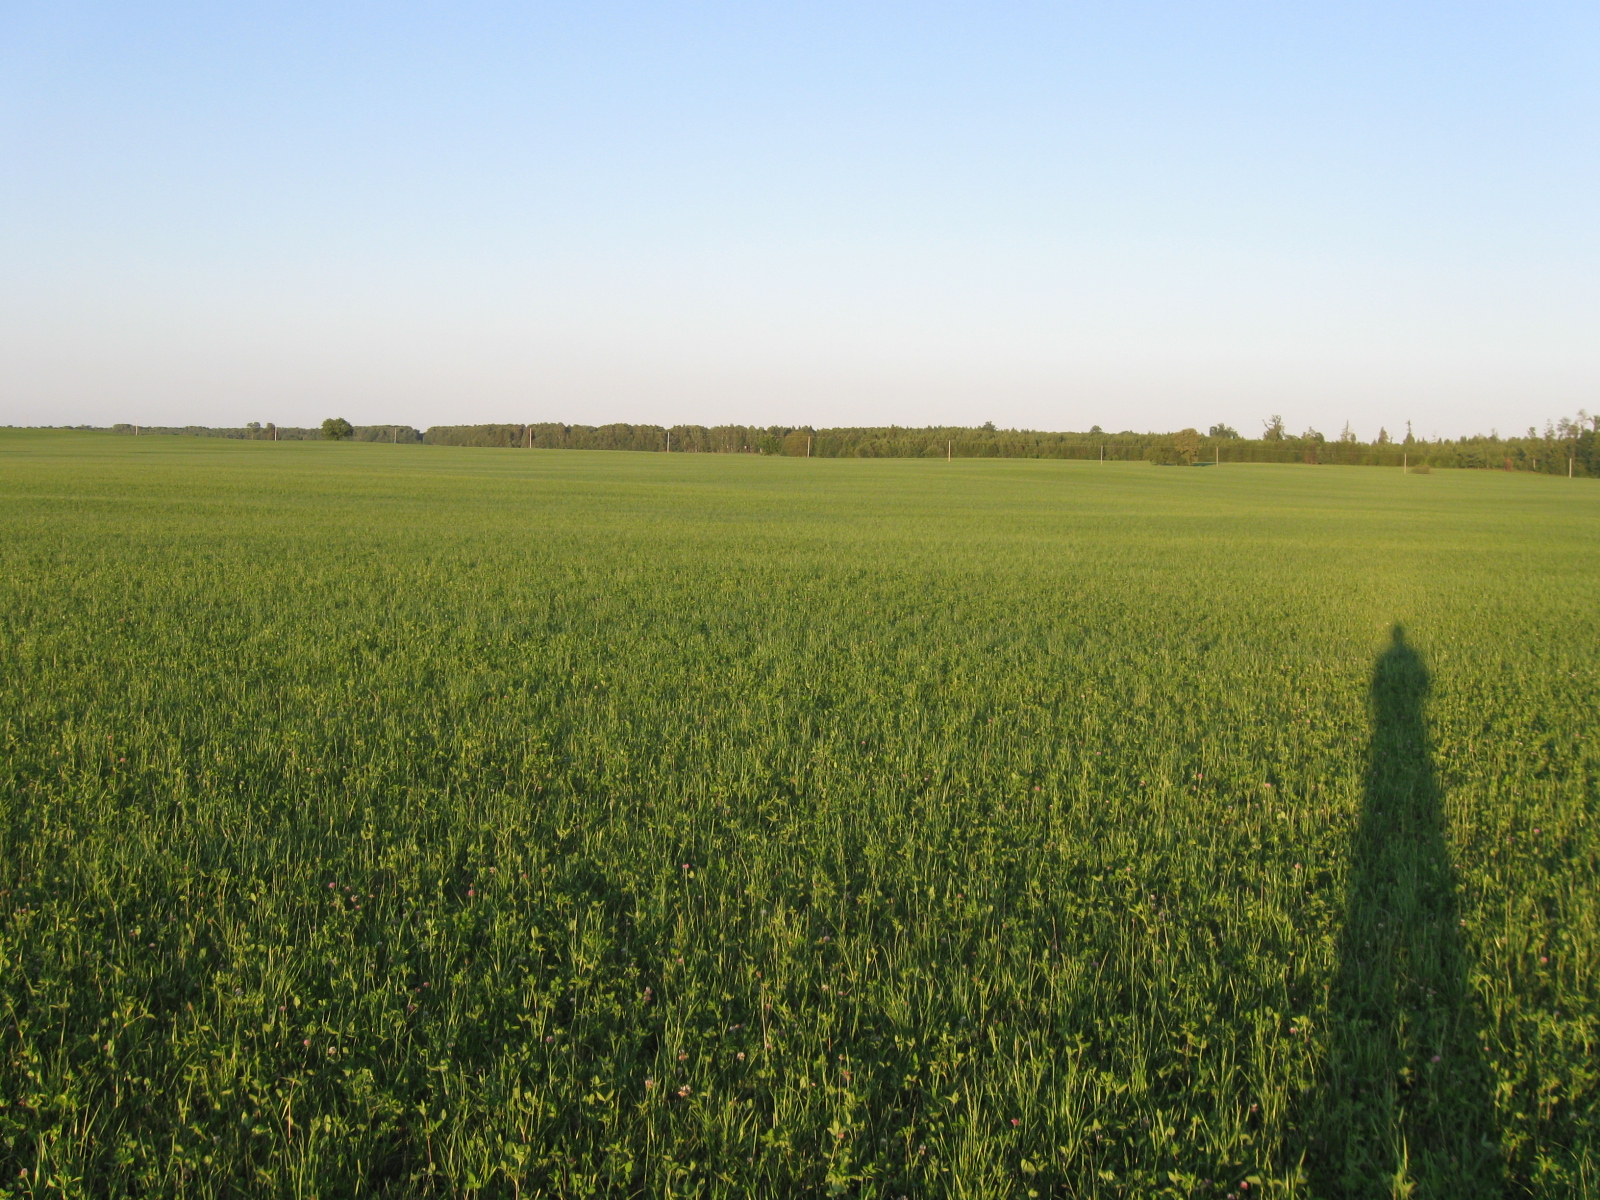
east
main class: Cropland
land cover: Other leguminous and mixtures for fodder
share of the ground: > 75 %
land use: Agriculture (excluding fallow land and kitchen gardens)
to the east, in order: Other leguminous and mixtures for fodder
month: July
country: LT
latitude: 55.0900
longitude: 23.6360
